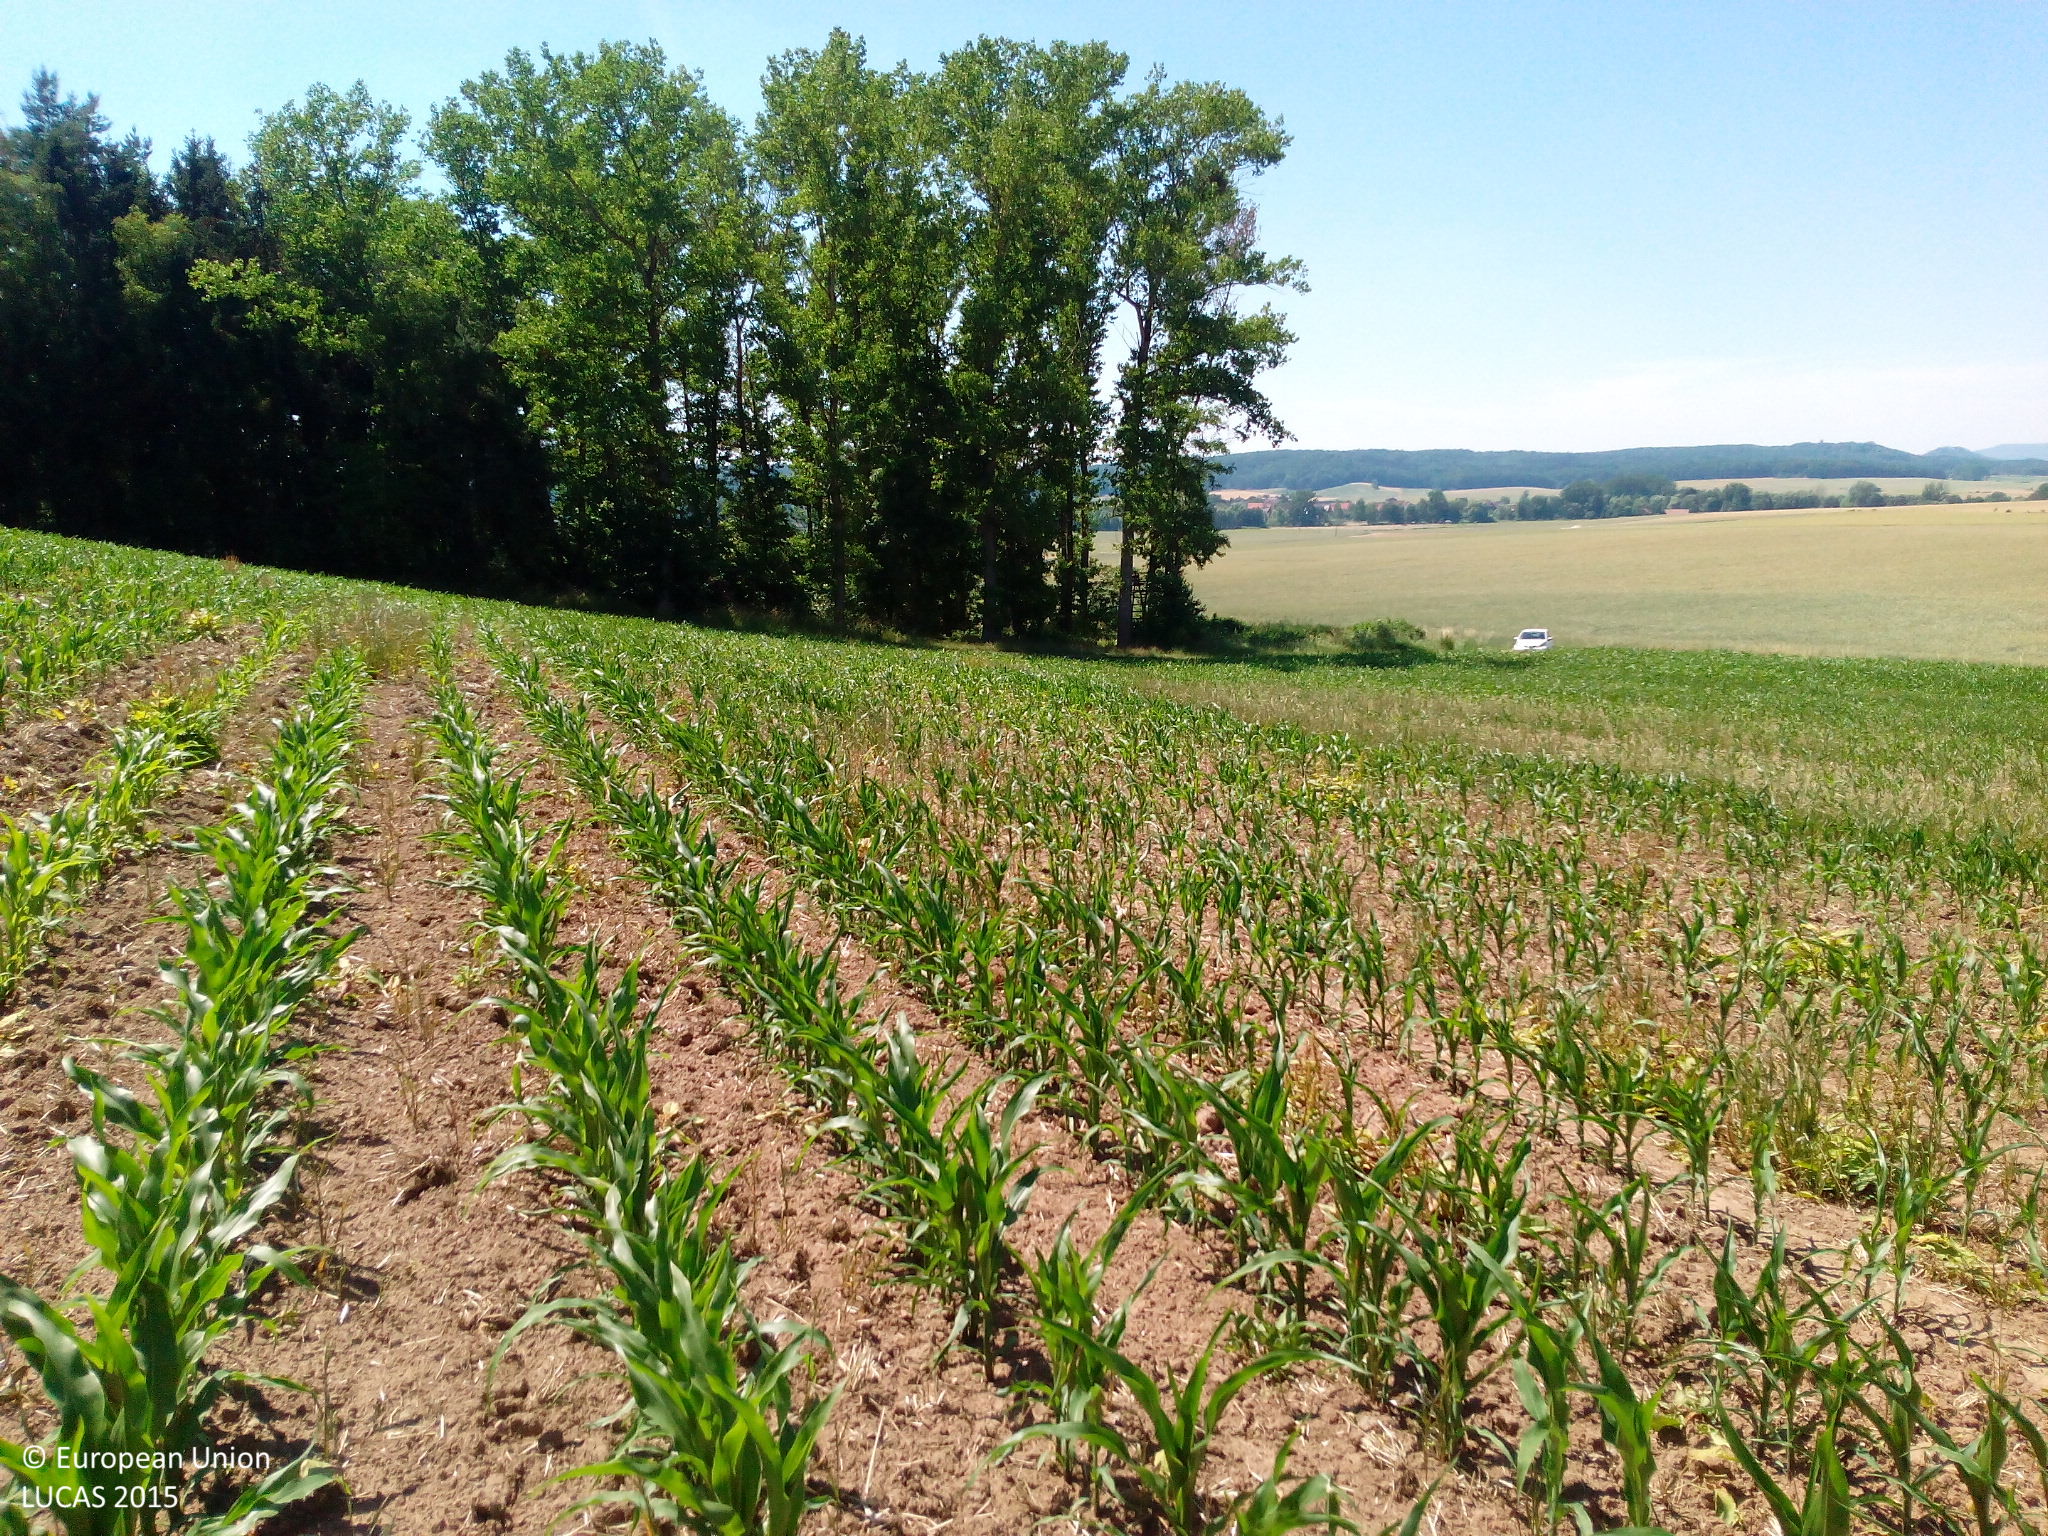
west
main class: Cropland
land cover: Maize
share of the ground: 25 - 50 %
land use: Agriculture (excluding fallow land and kitchen gardens)
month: July
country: DE
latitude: 50.3071
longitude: 10.8282
